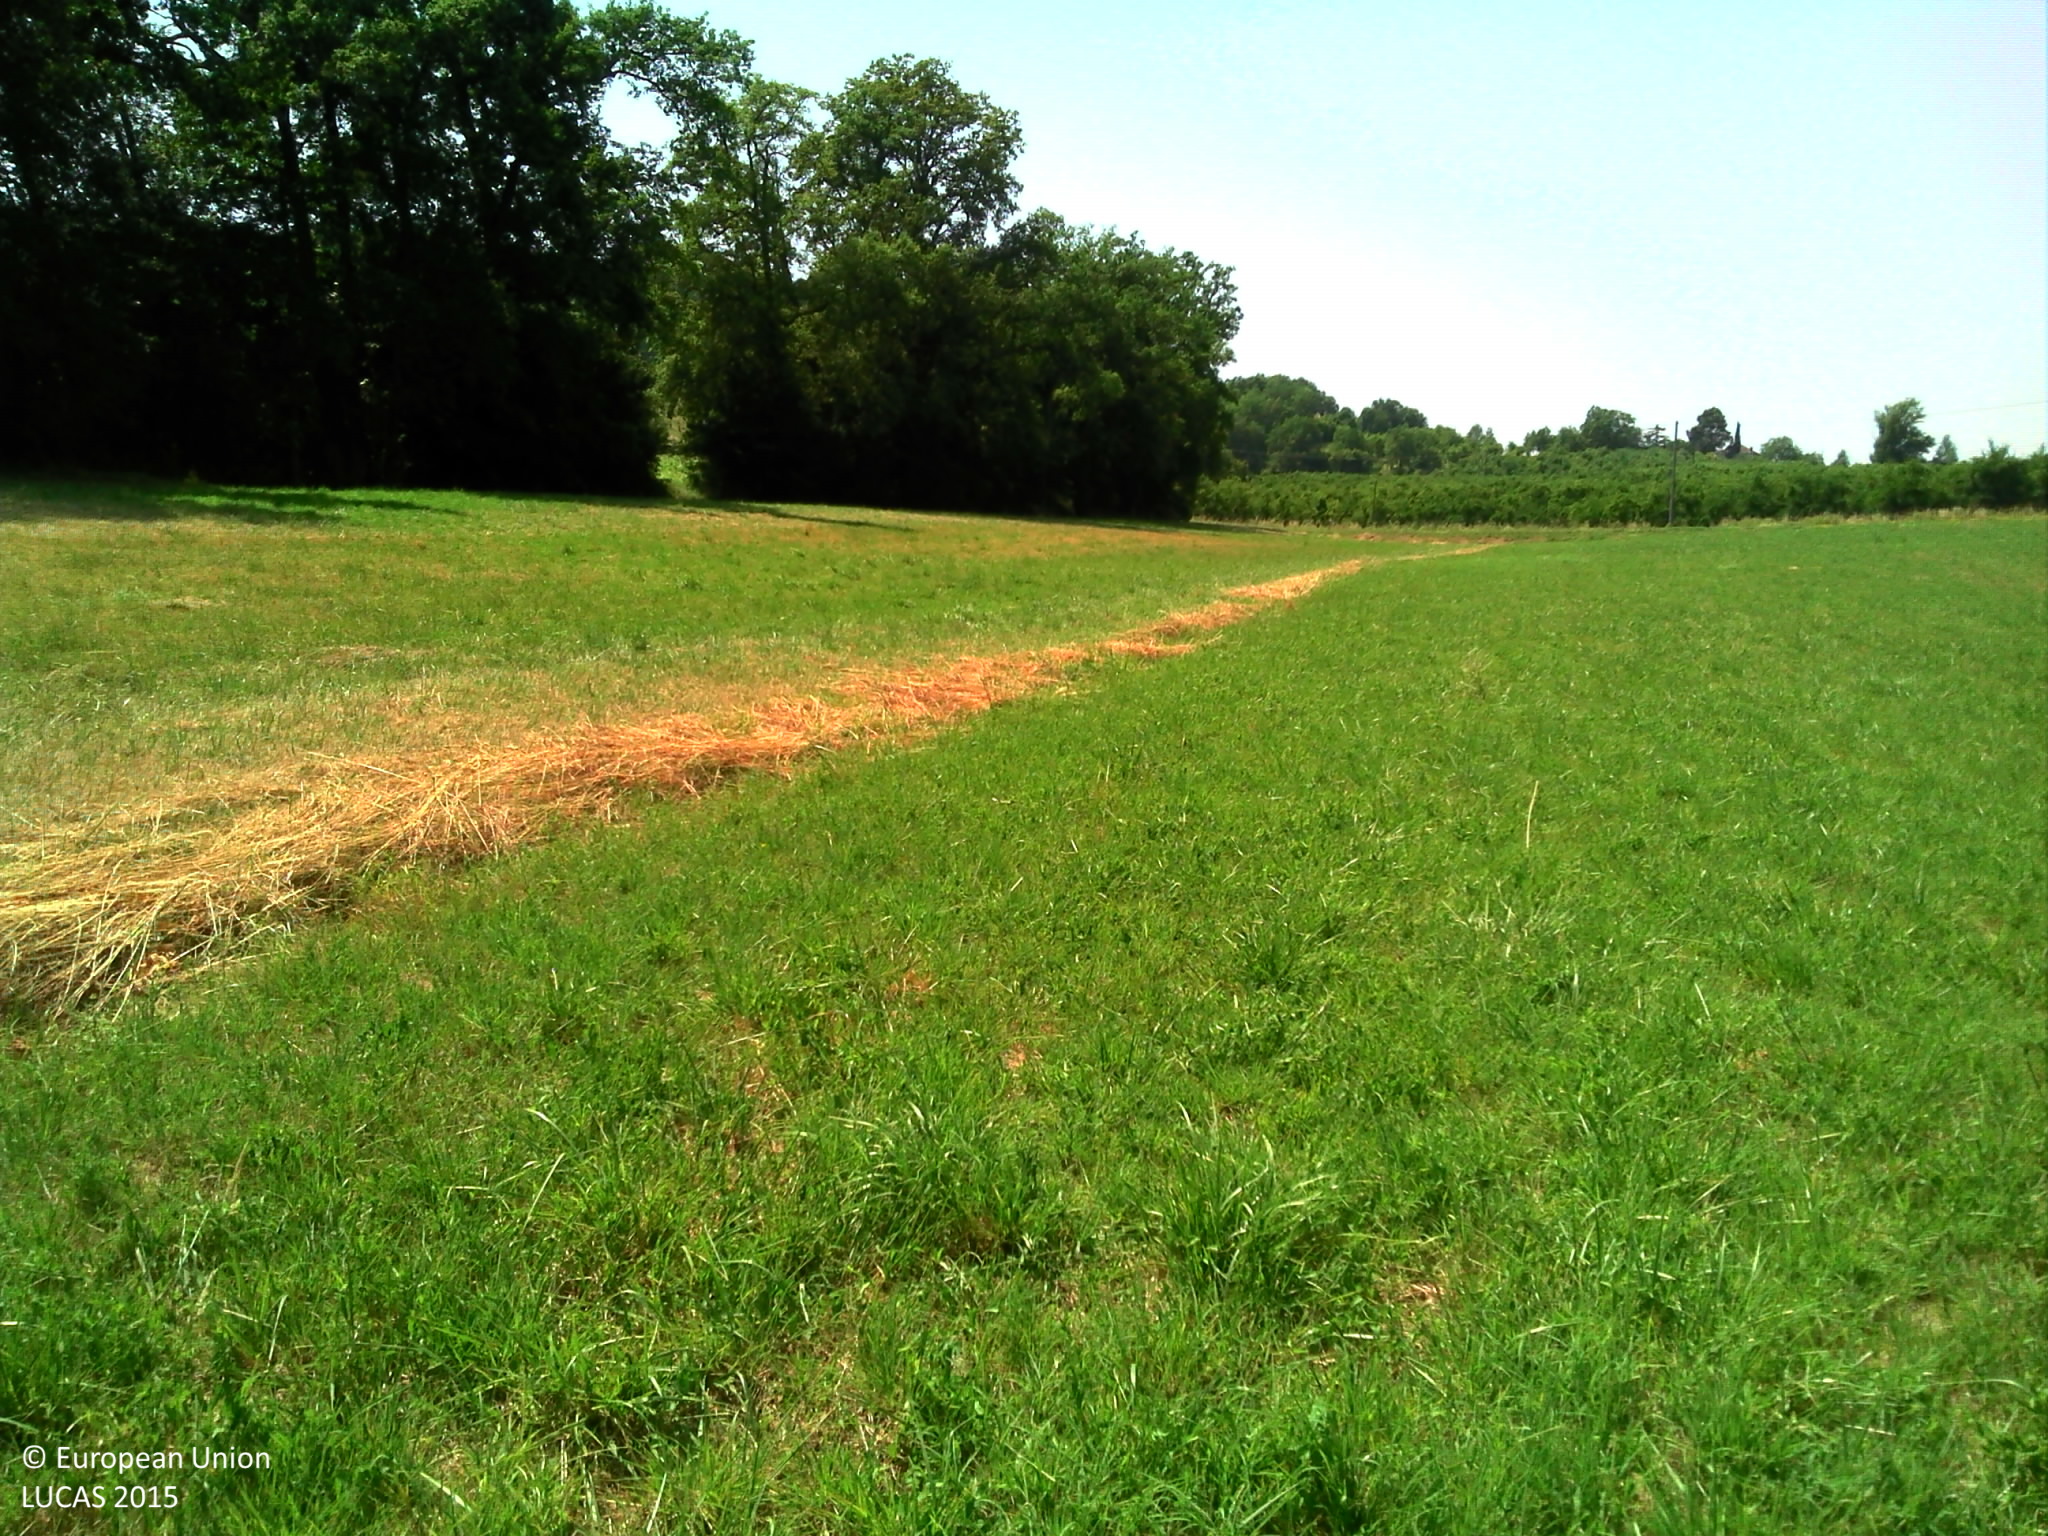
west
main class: Grassland
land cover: Grassland without tree/shrub cover
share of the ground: > 75 %
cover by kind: herbaceous plants 100 %
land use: Agriculture (excluding fallow land and kitchen gardens)
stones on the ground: < 10 %
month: July
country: FR
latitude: 44.4543
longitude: 0.8585
